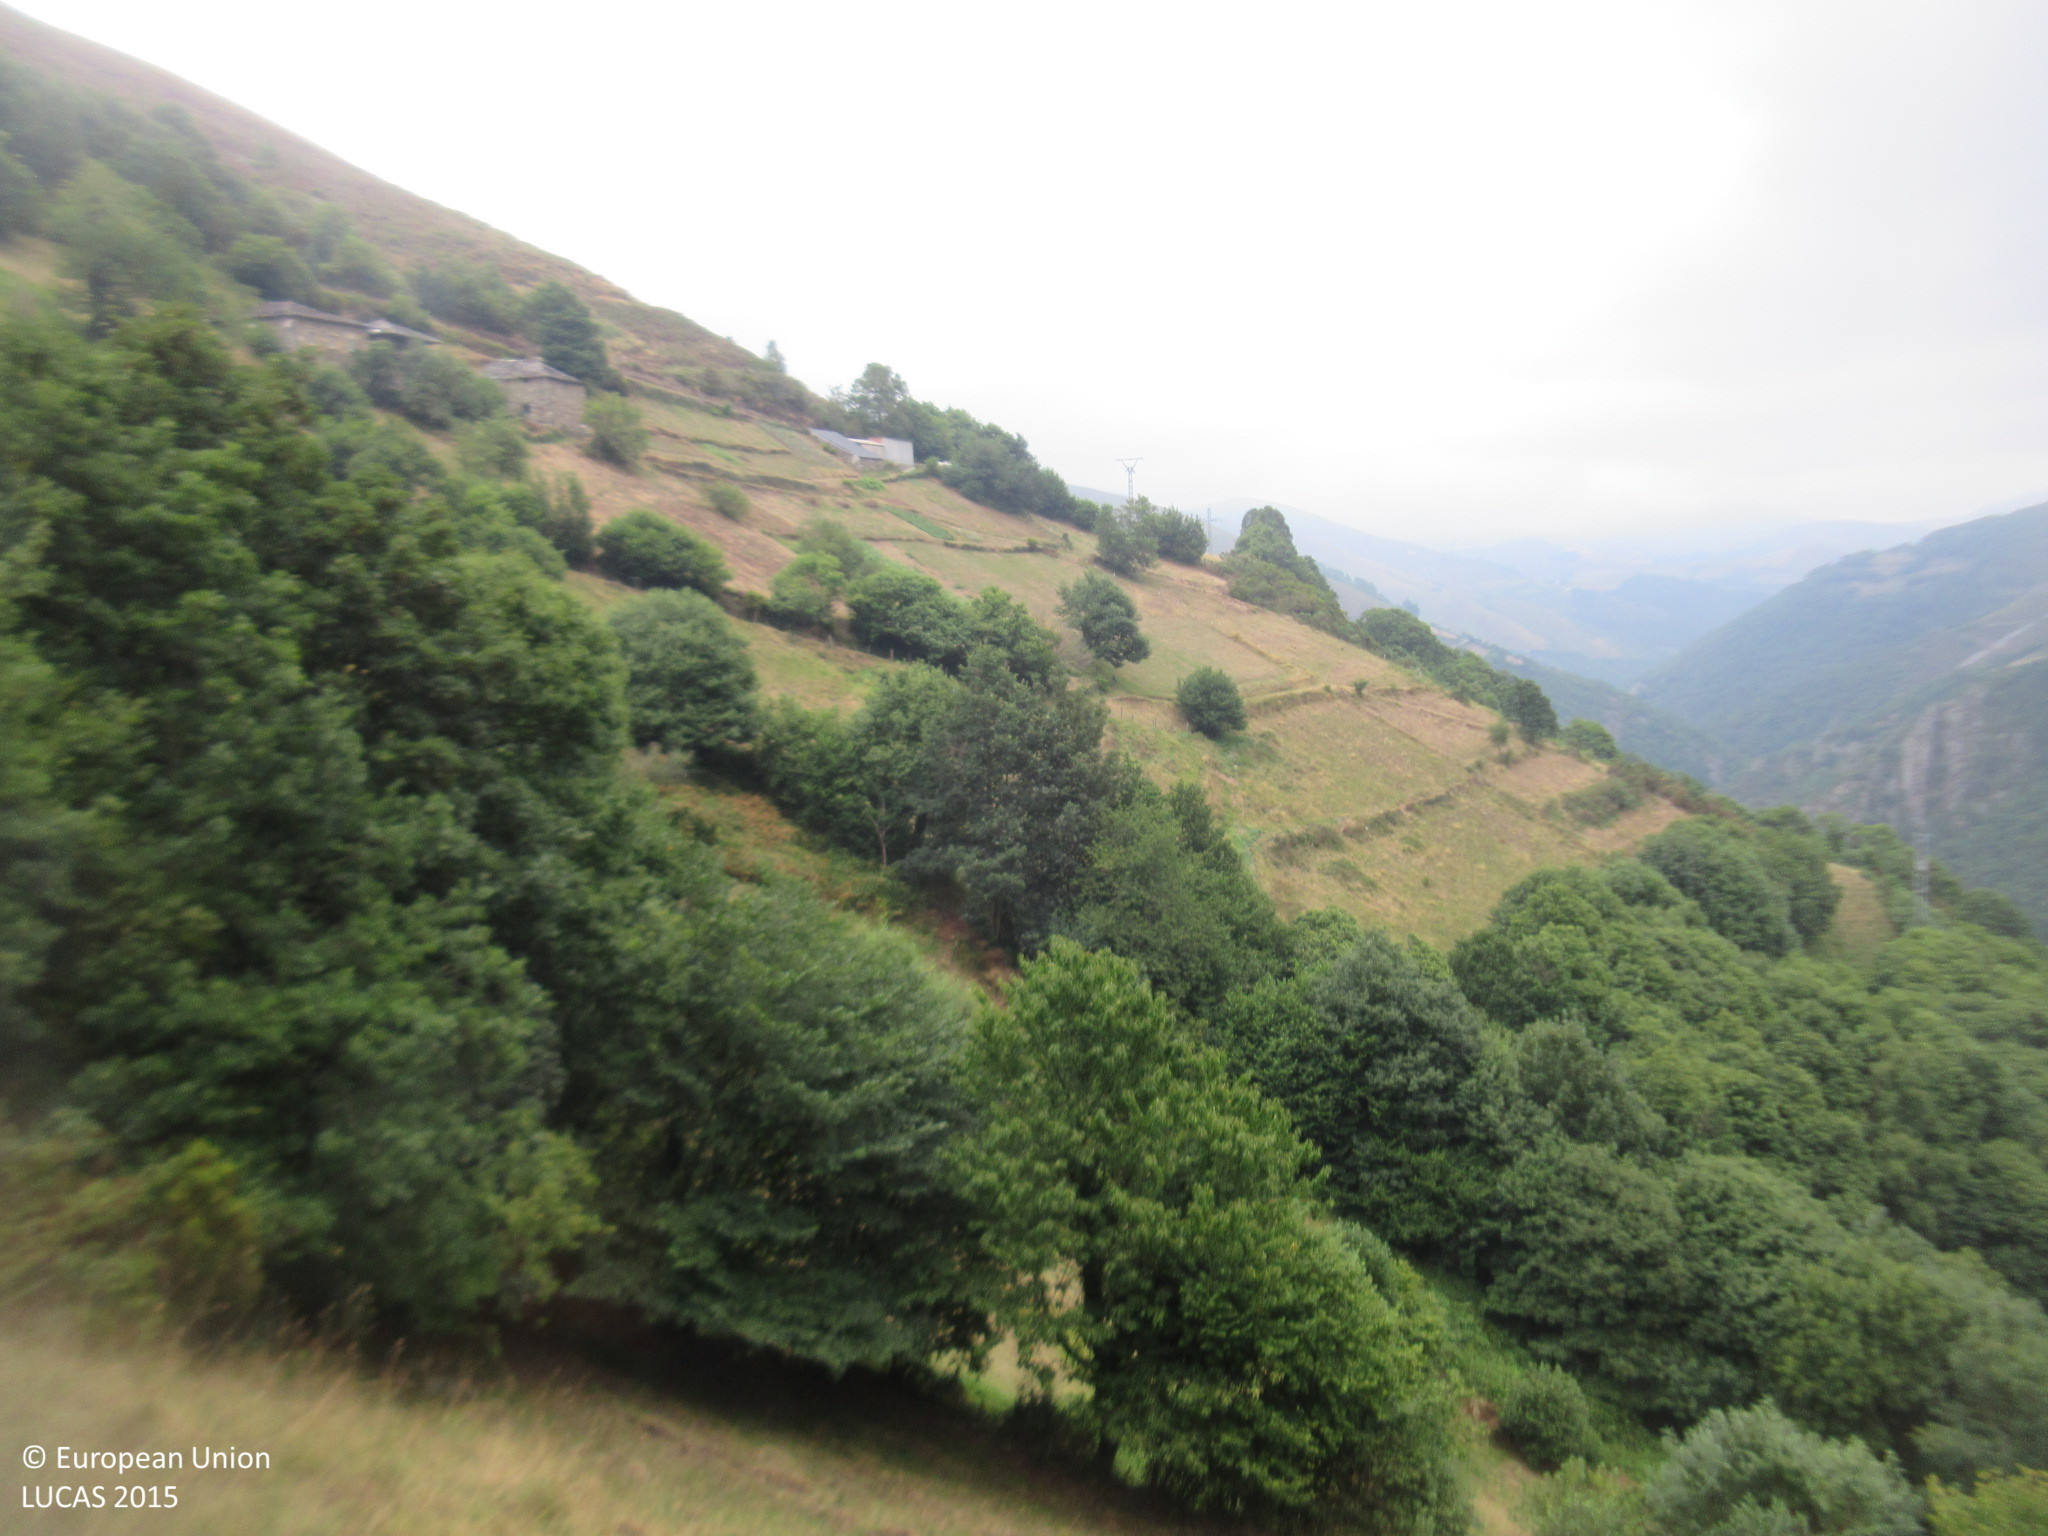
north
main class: Grassland
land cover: Grassland without tree/shrub cover
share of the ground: > 75 %
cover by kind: herbaceous plants 100 %
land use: Agriculture (excluding fallow land and kitchen gardens)
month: August
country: ES
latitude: 43.3610
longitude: -6.6537
